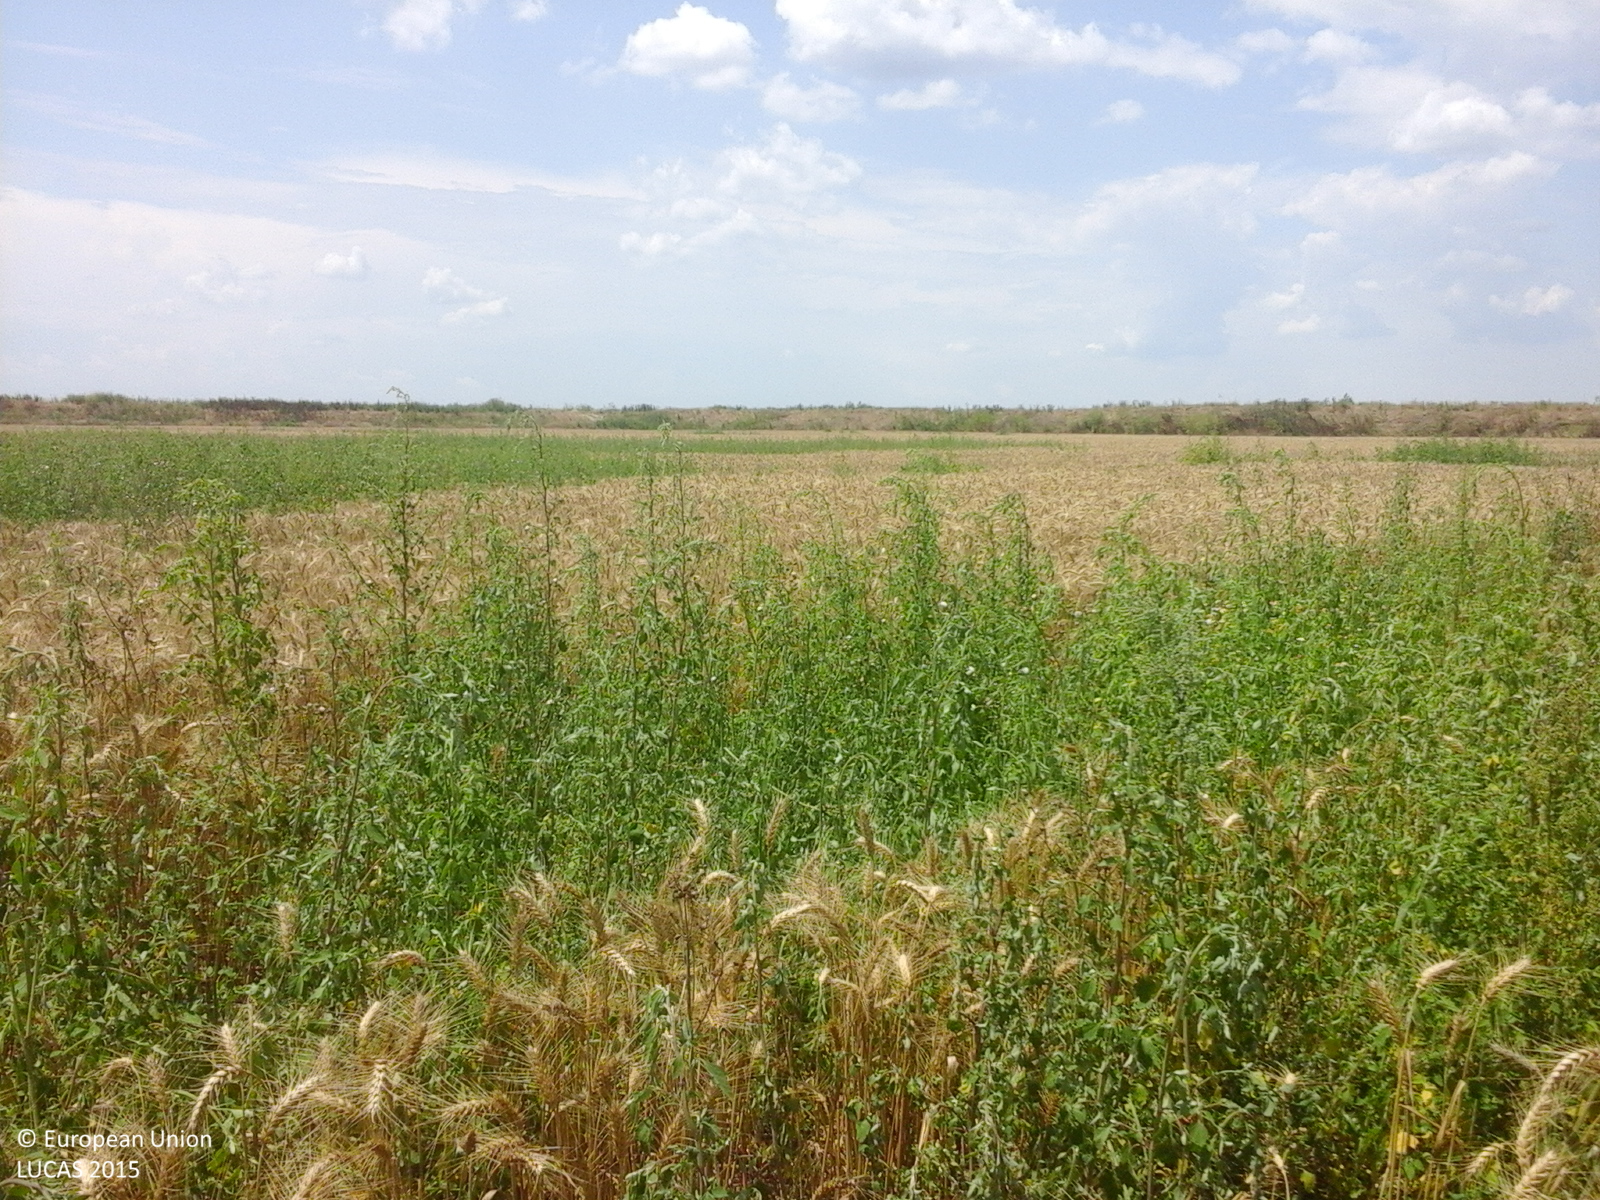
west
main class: Cropland
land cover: Common wheat
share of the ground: > 75 %
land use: Agriculture (excluding fallow land and kitchen gardens)
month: June
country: RO
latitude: 44.0889
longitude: 26.5872
